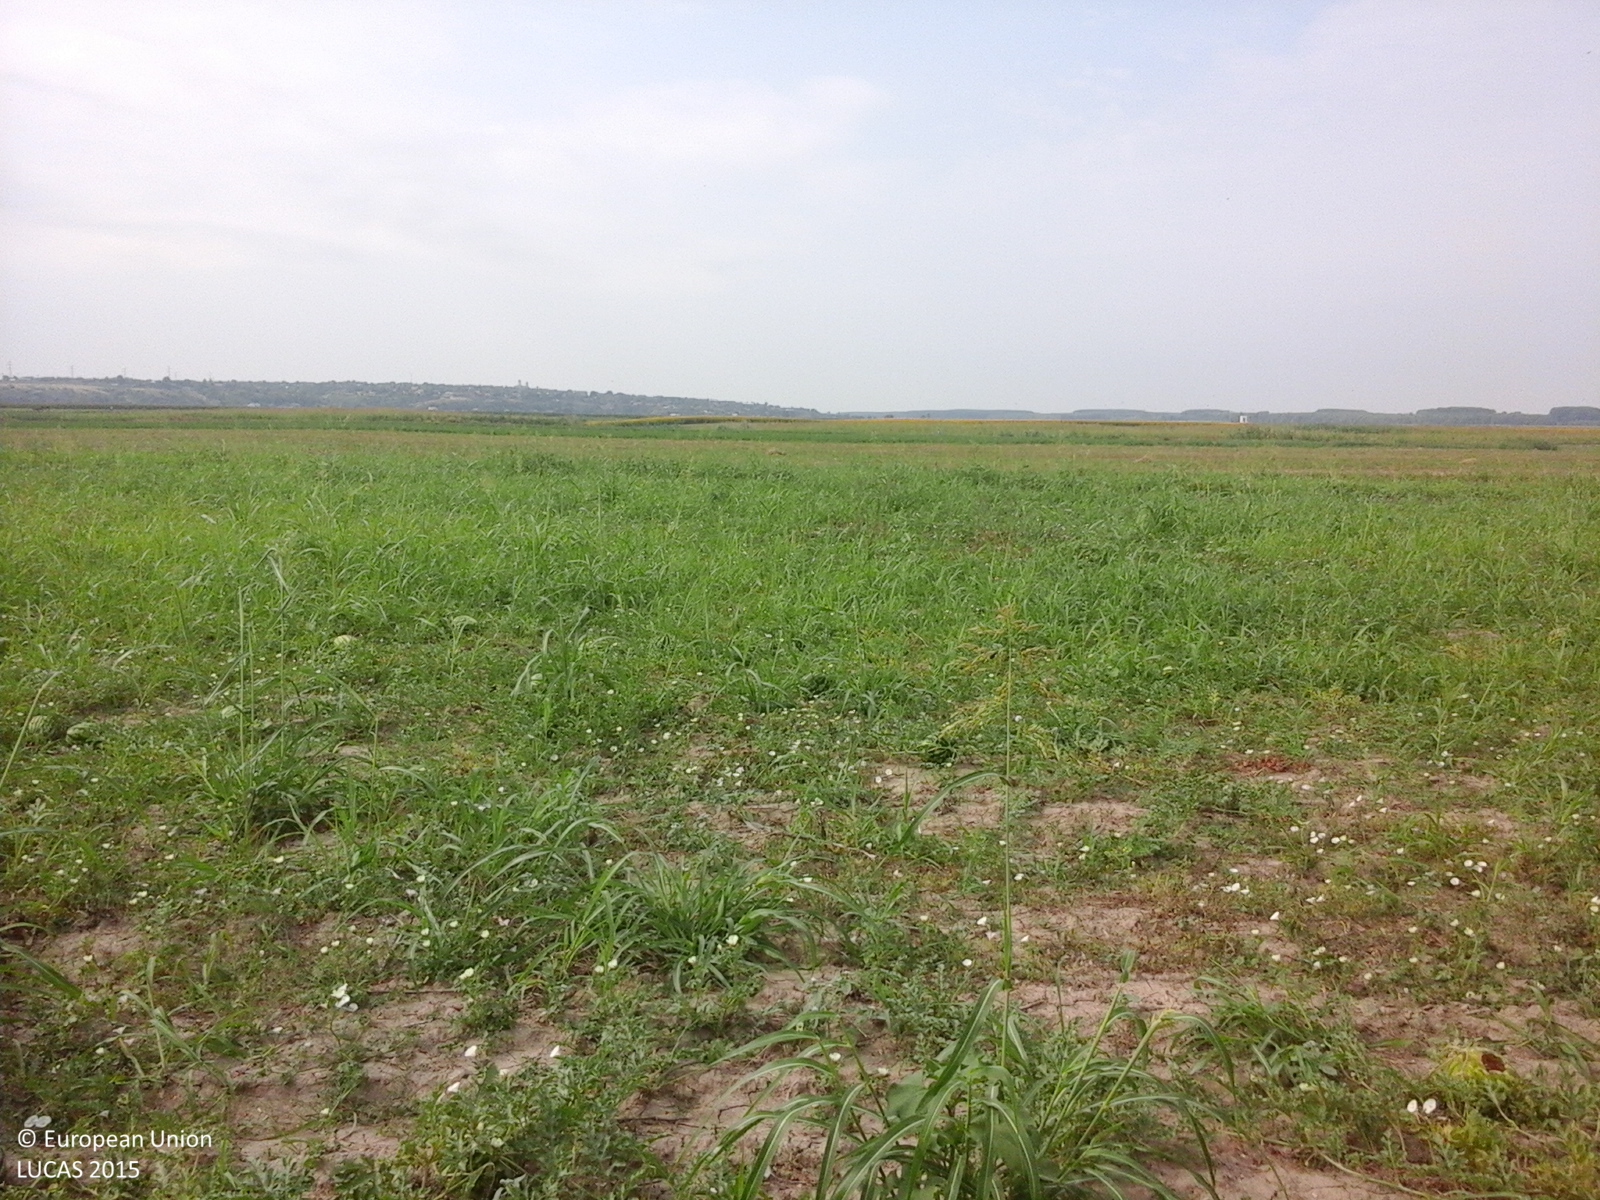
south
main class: Cropland
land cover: Other fresh vegetables
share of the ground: > 75 %
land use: Agriculture (excluding fallow land and kitchen gardens)
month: July
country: RO
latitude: 44.9470
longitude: 28.1524
